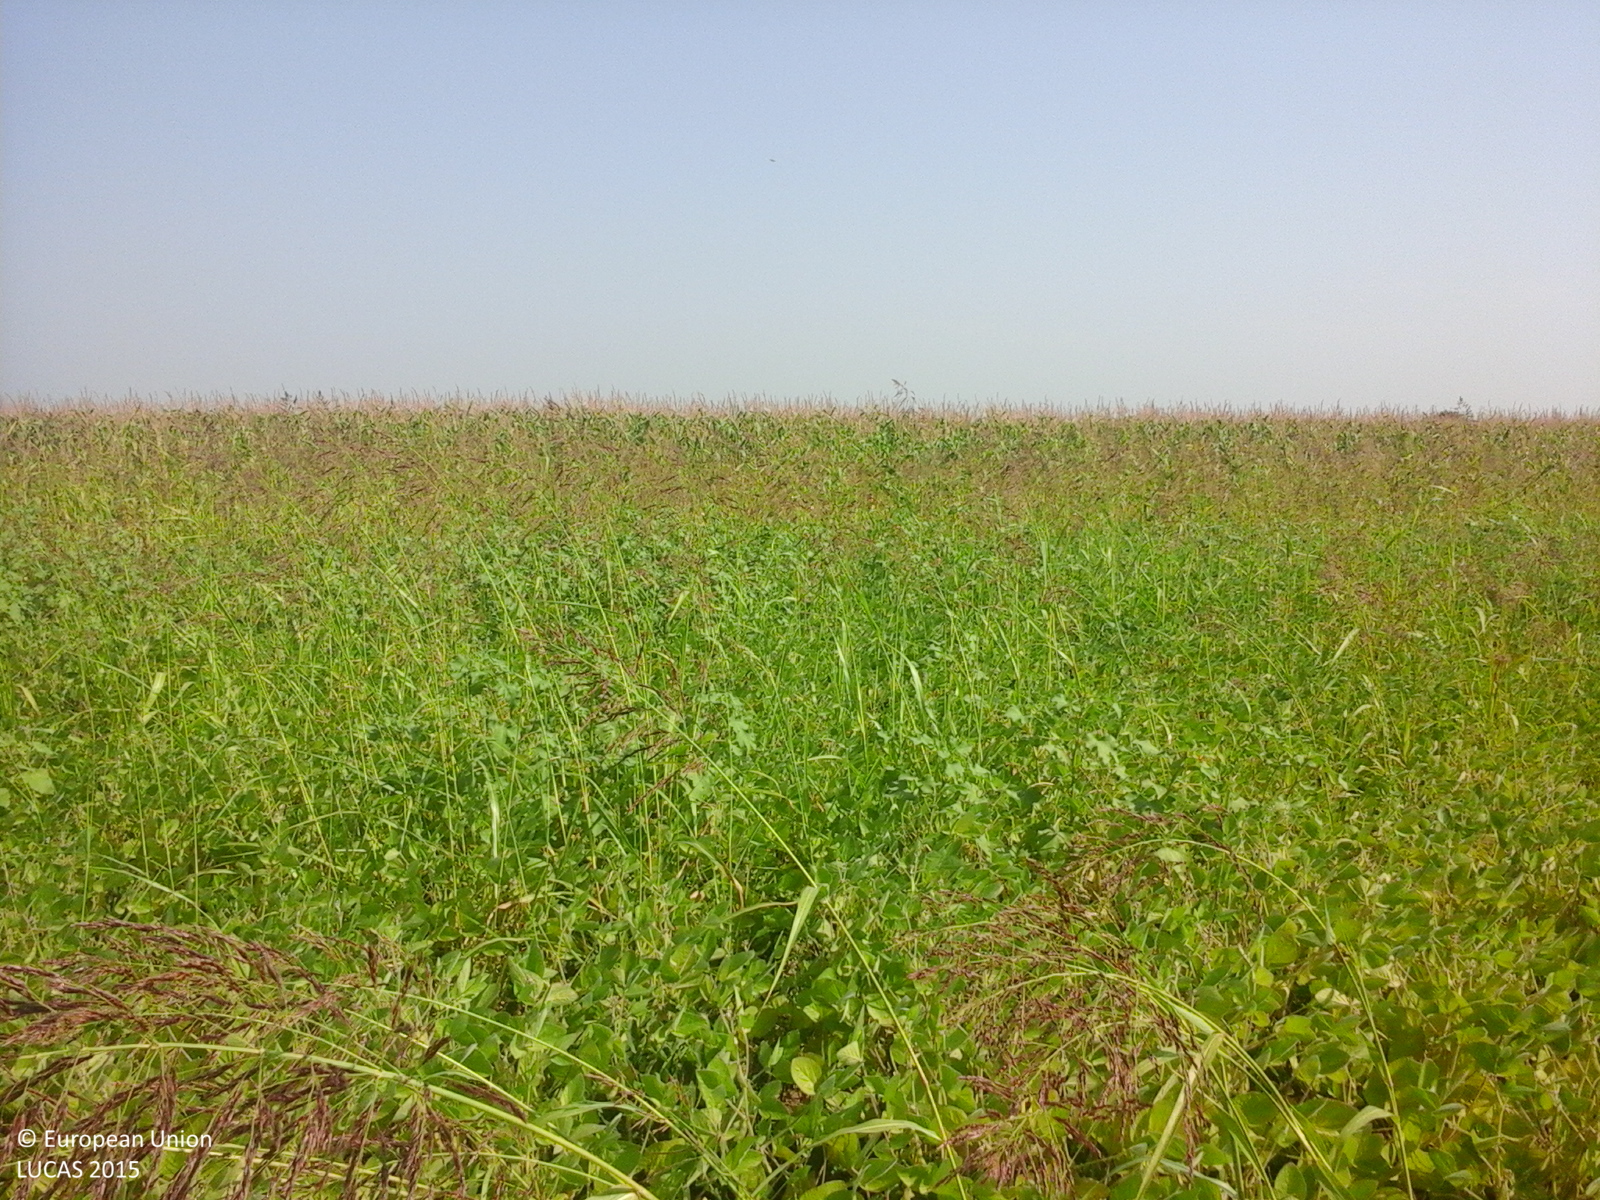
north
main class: Cropland
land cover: Soya
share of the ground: > 75 %
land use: Agriculture (excluding fallow land and kitchen gardens)
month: August
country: RO
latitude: 45.0966
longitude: 27.3899
